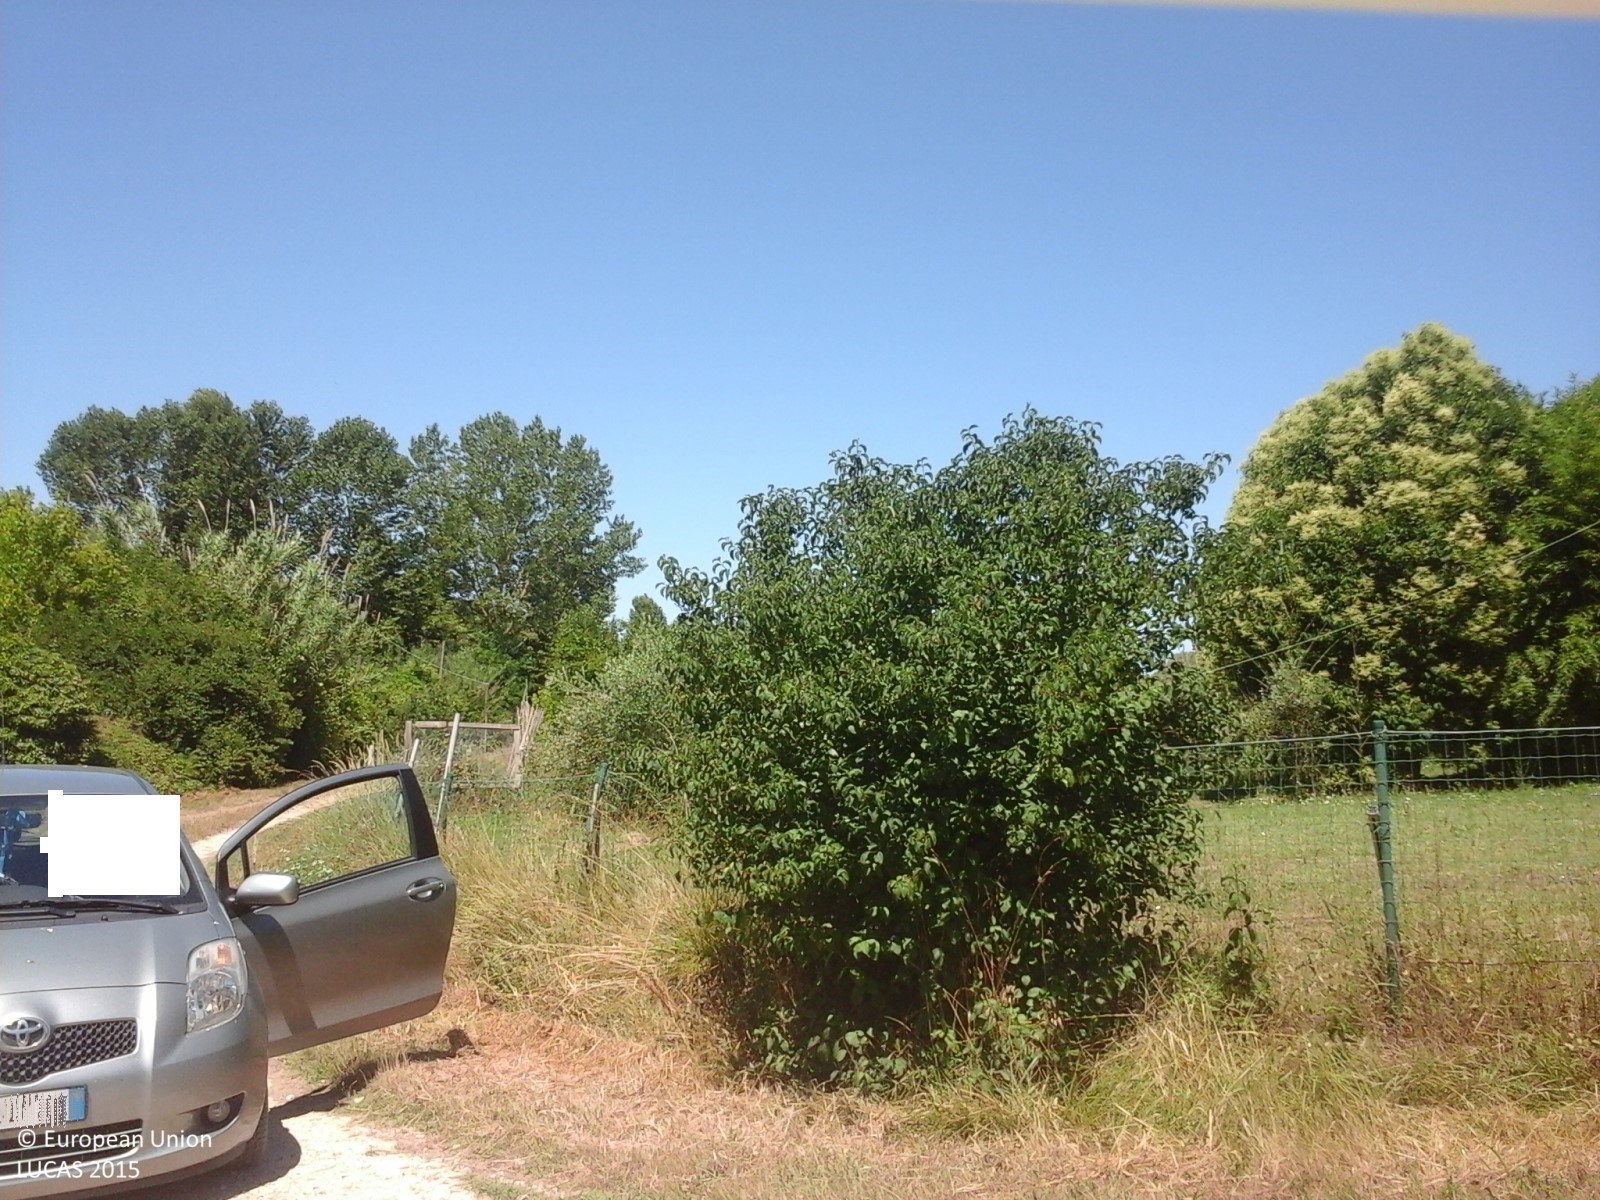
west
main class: Cropland
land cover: Olive groves
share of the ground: 50 - 75 %
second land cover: Grassland without tree/shrub cover
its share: 50 - 75 %
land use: Agriculture (excluding fallow land and kitchen gardens)
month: June
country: IT
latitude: 43.5730
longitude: 10.6051
